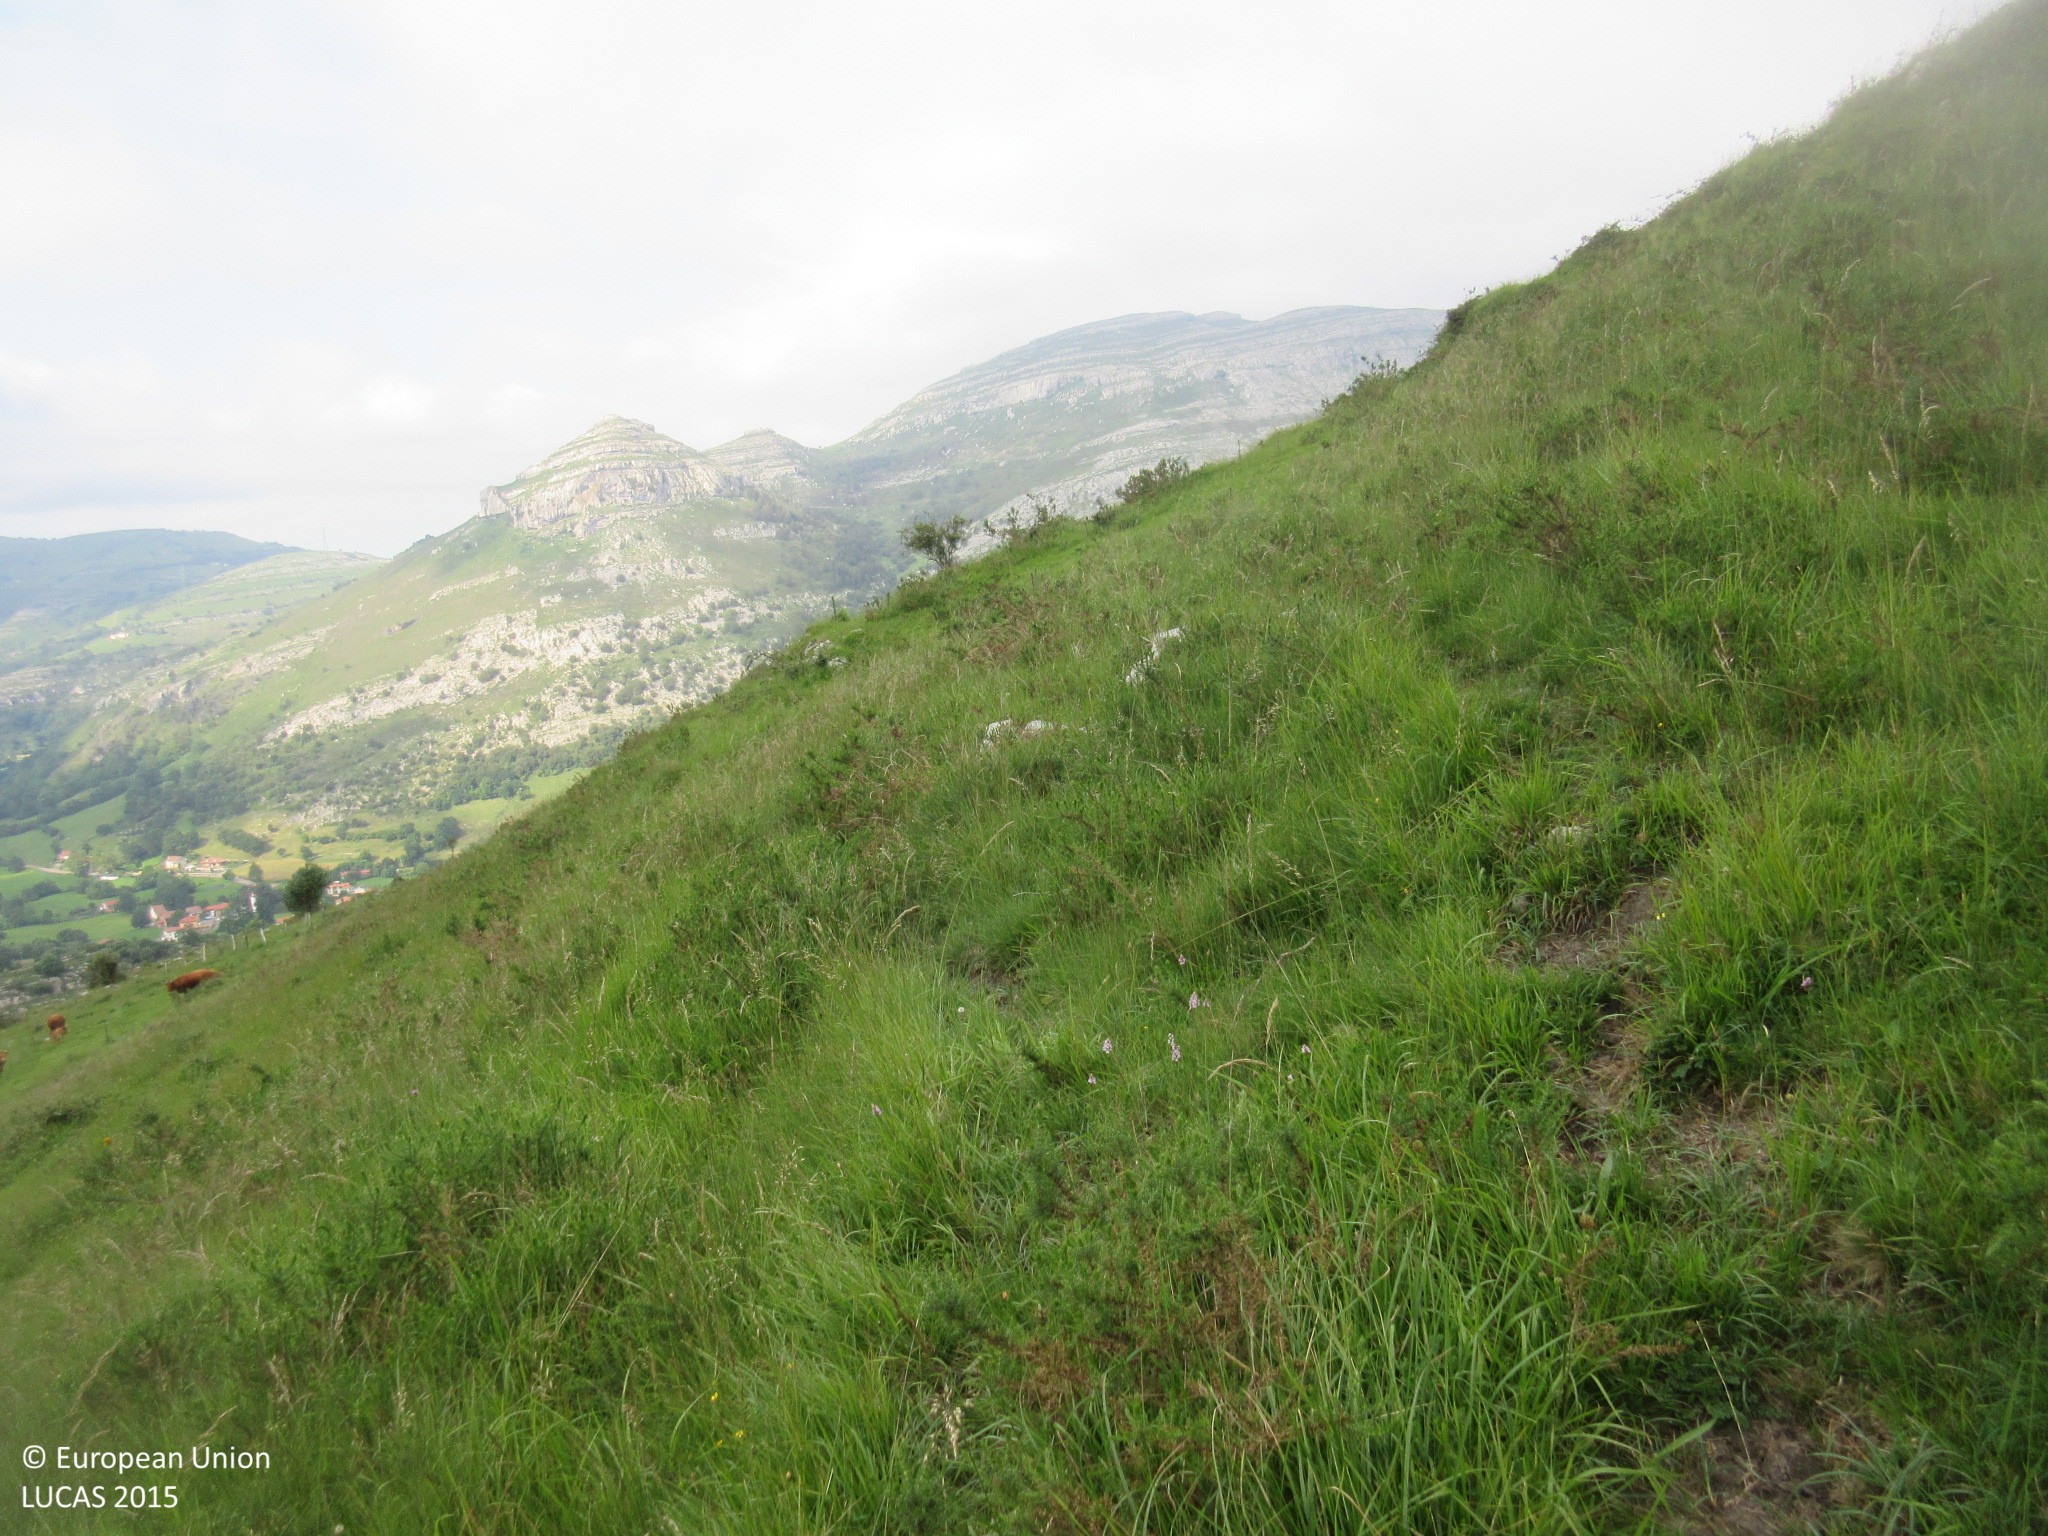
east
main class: Grassland
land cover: Grassland without tree/shrub cover
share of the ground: > 75 %
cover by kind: herbaceous plants 95 %, shrubs 5 %
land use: Agriculture (excluding fallow land and kitchen gardens)
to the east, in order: Grassland without tree/shrub cover; Fences; Grassland without tree/shrub cover
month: June
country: ES
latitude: 43.3052
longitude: -3.5926
